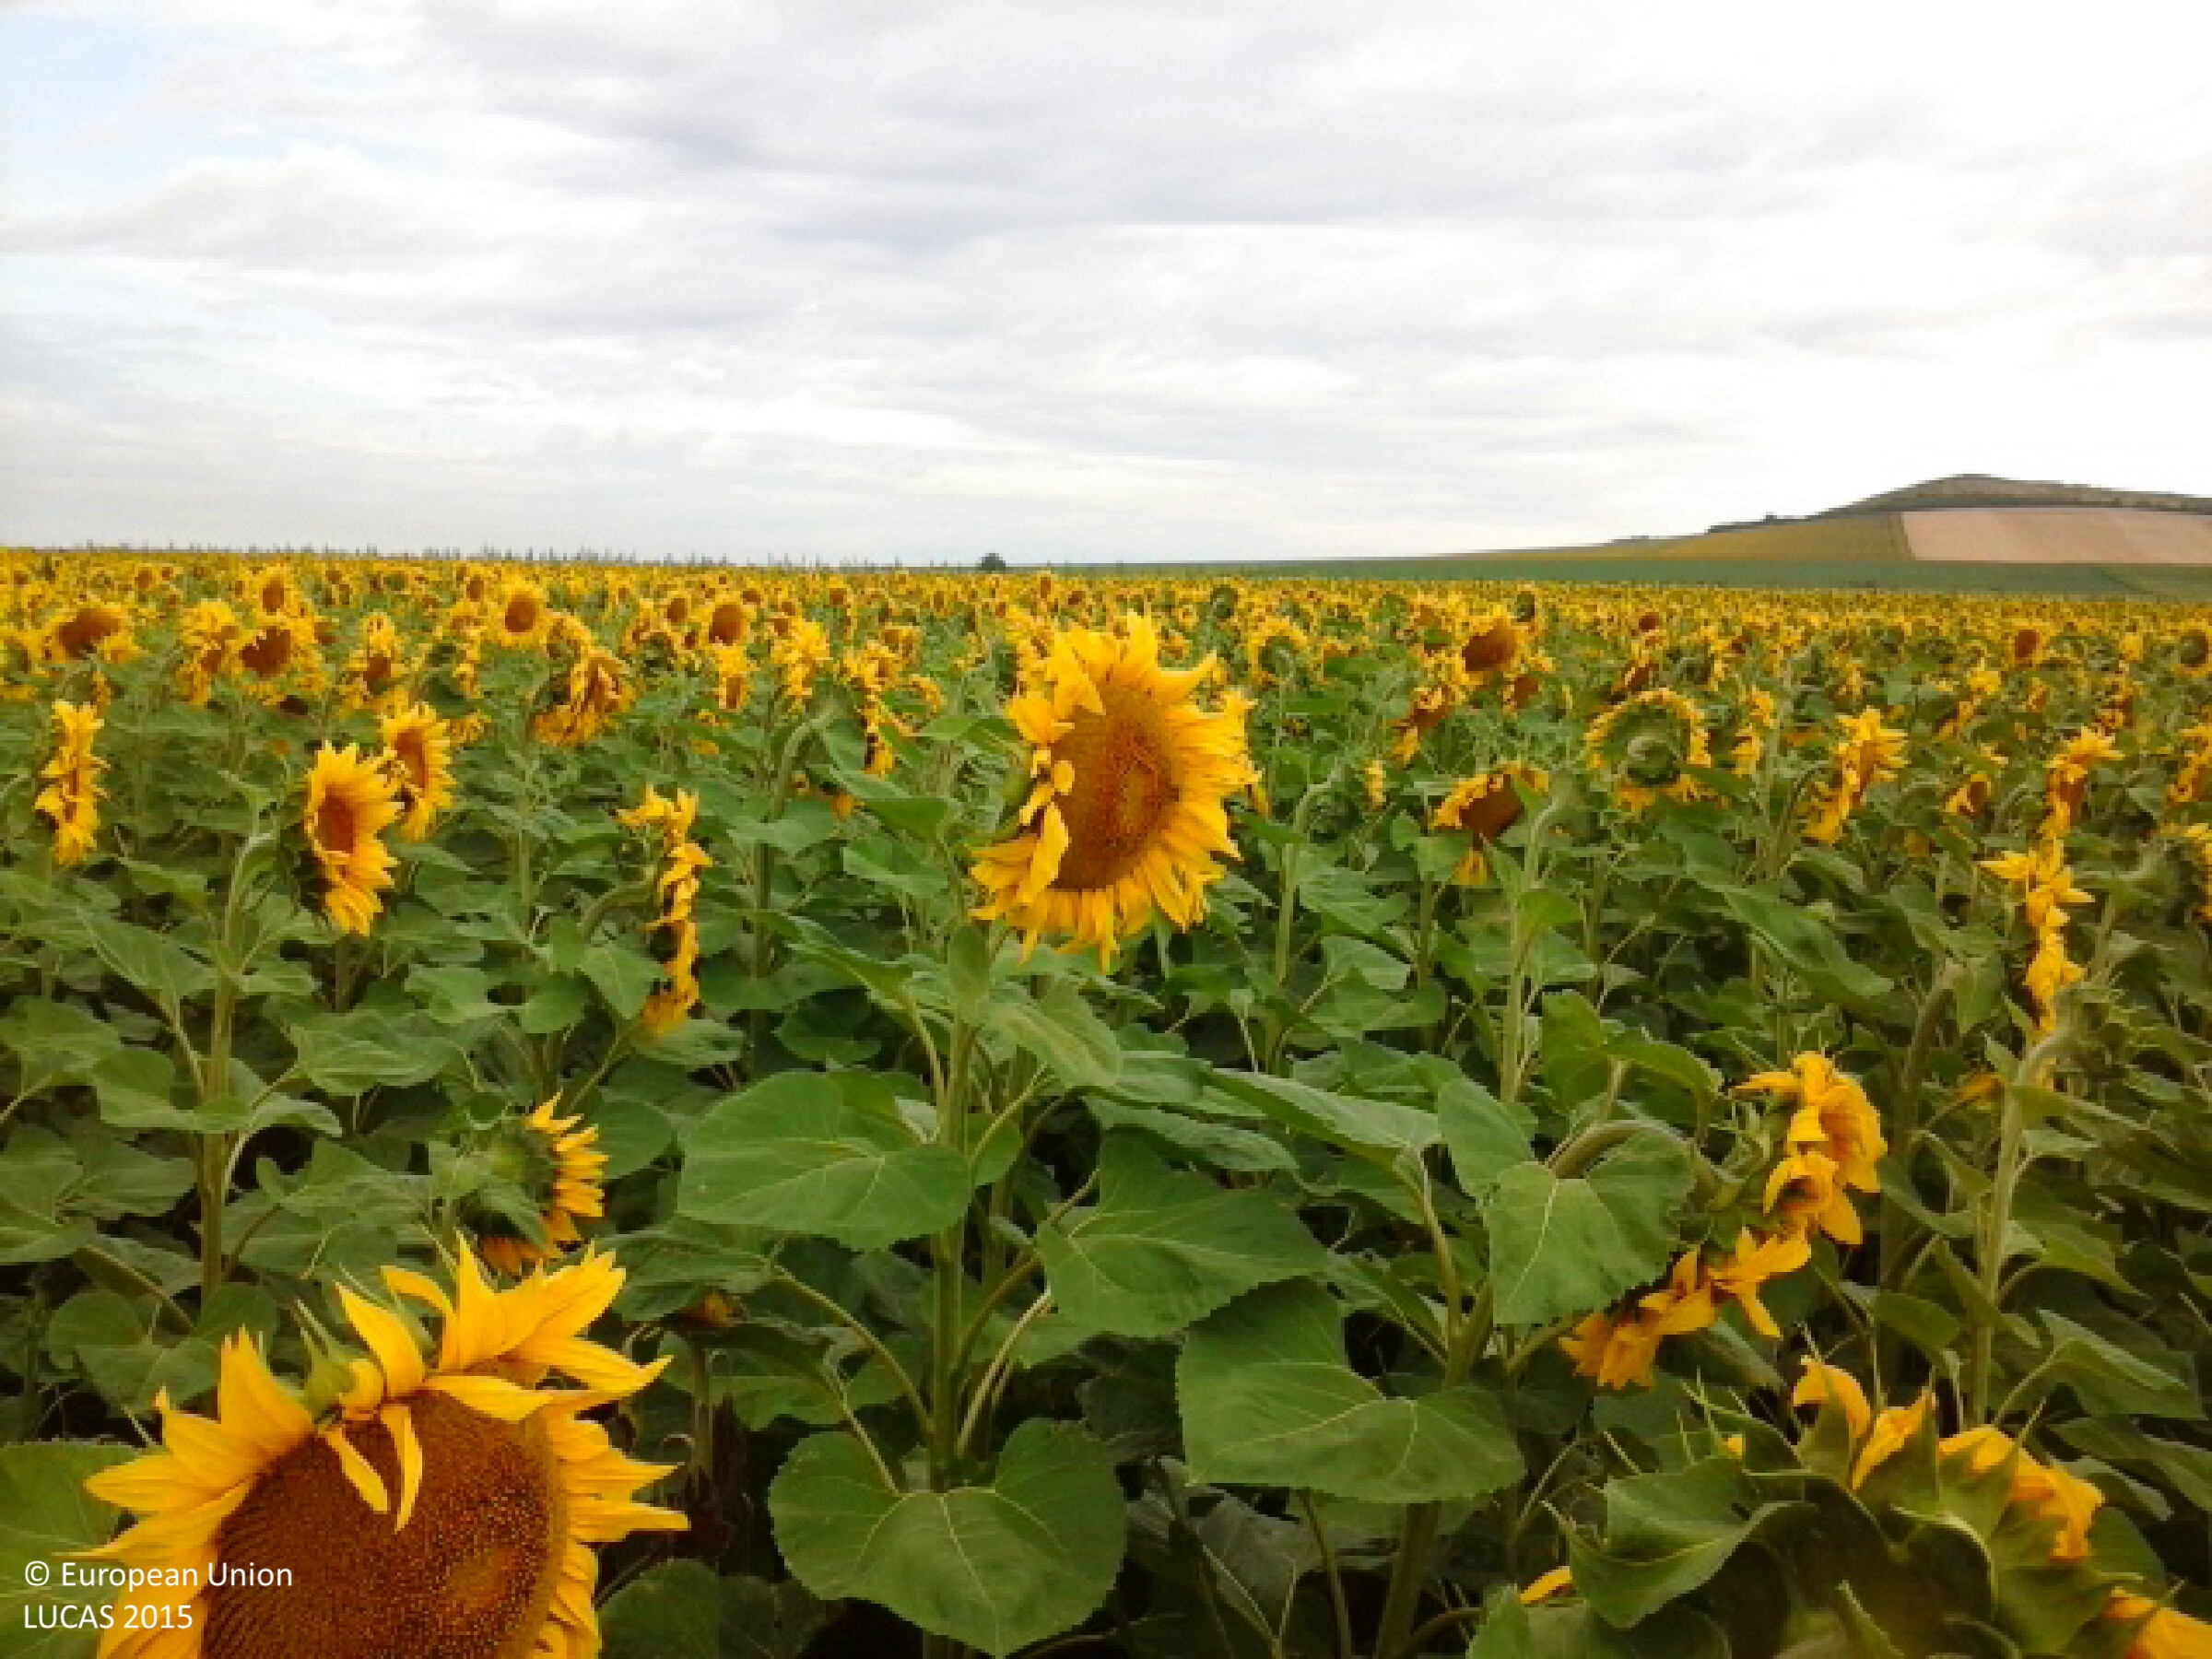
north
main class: Cropland
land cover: Sunflower
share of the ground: > 75 %
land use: Agriculture (excluding fallow land and kitchen gardens)
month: July
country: HU
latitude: 48.2195
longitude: 21.1457
